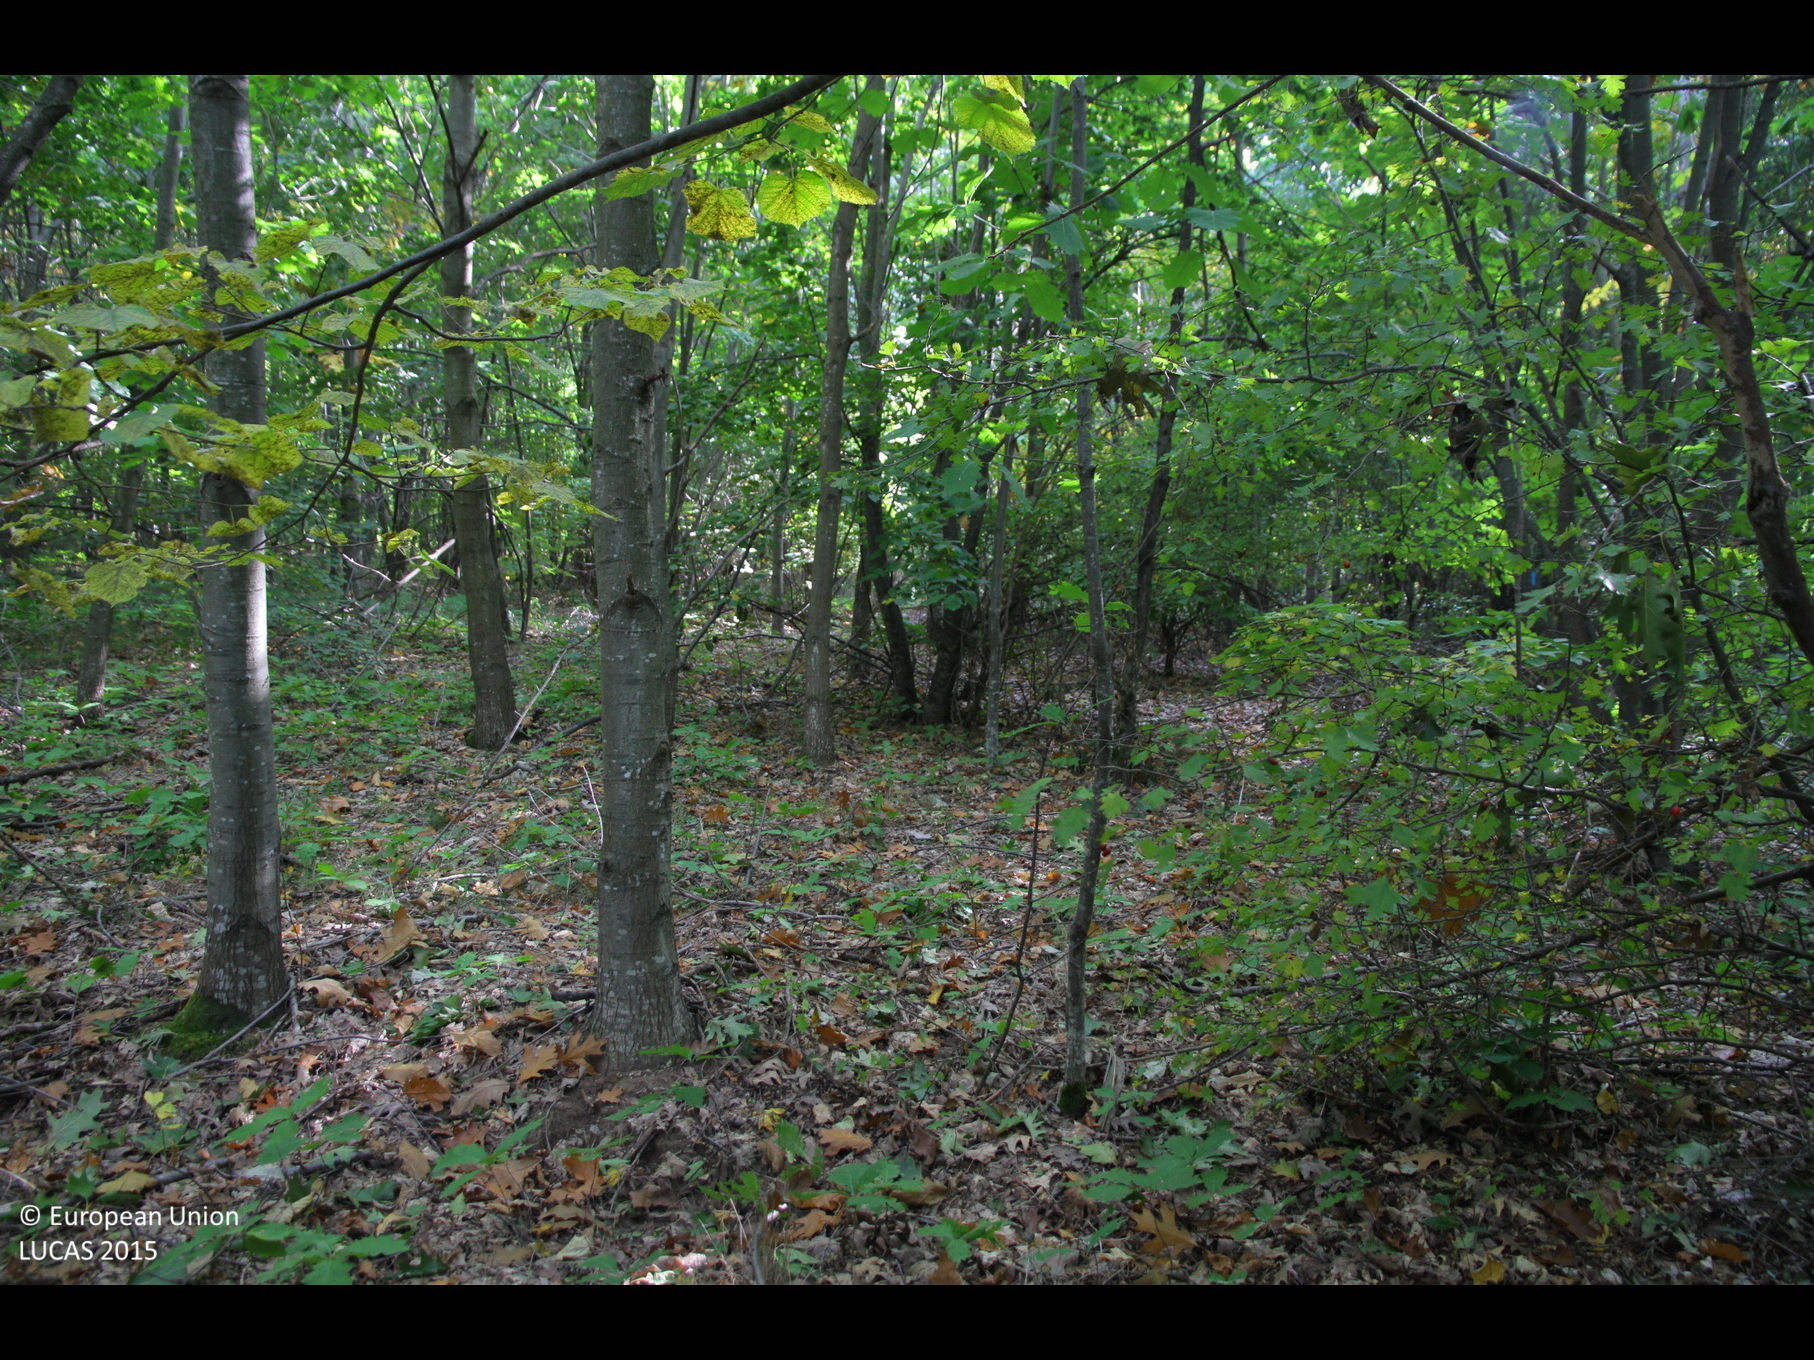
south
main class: Woodland
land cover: Broadleaved woodland
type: acidophilous oak and oak-birch forest
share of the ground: > 75 %
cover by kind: broadleaved forest trees 100 %
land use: Forestry
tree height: > 5 m
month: October
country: BG
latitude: 43.4863
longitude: 27.2236
